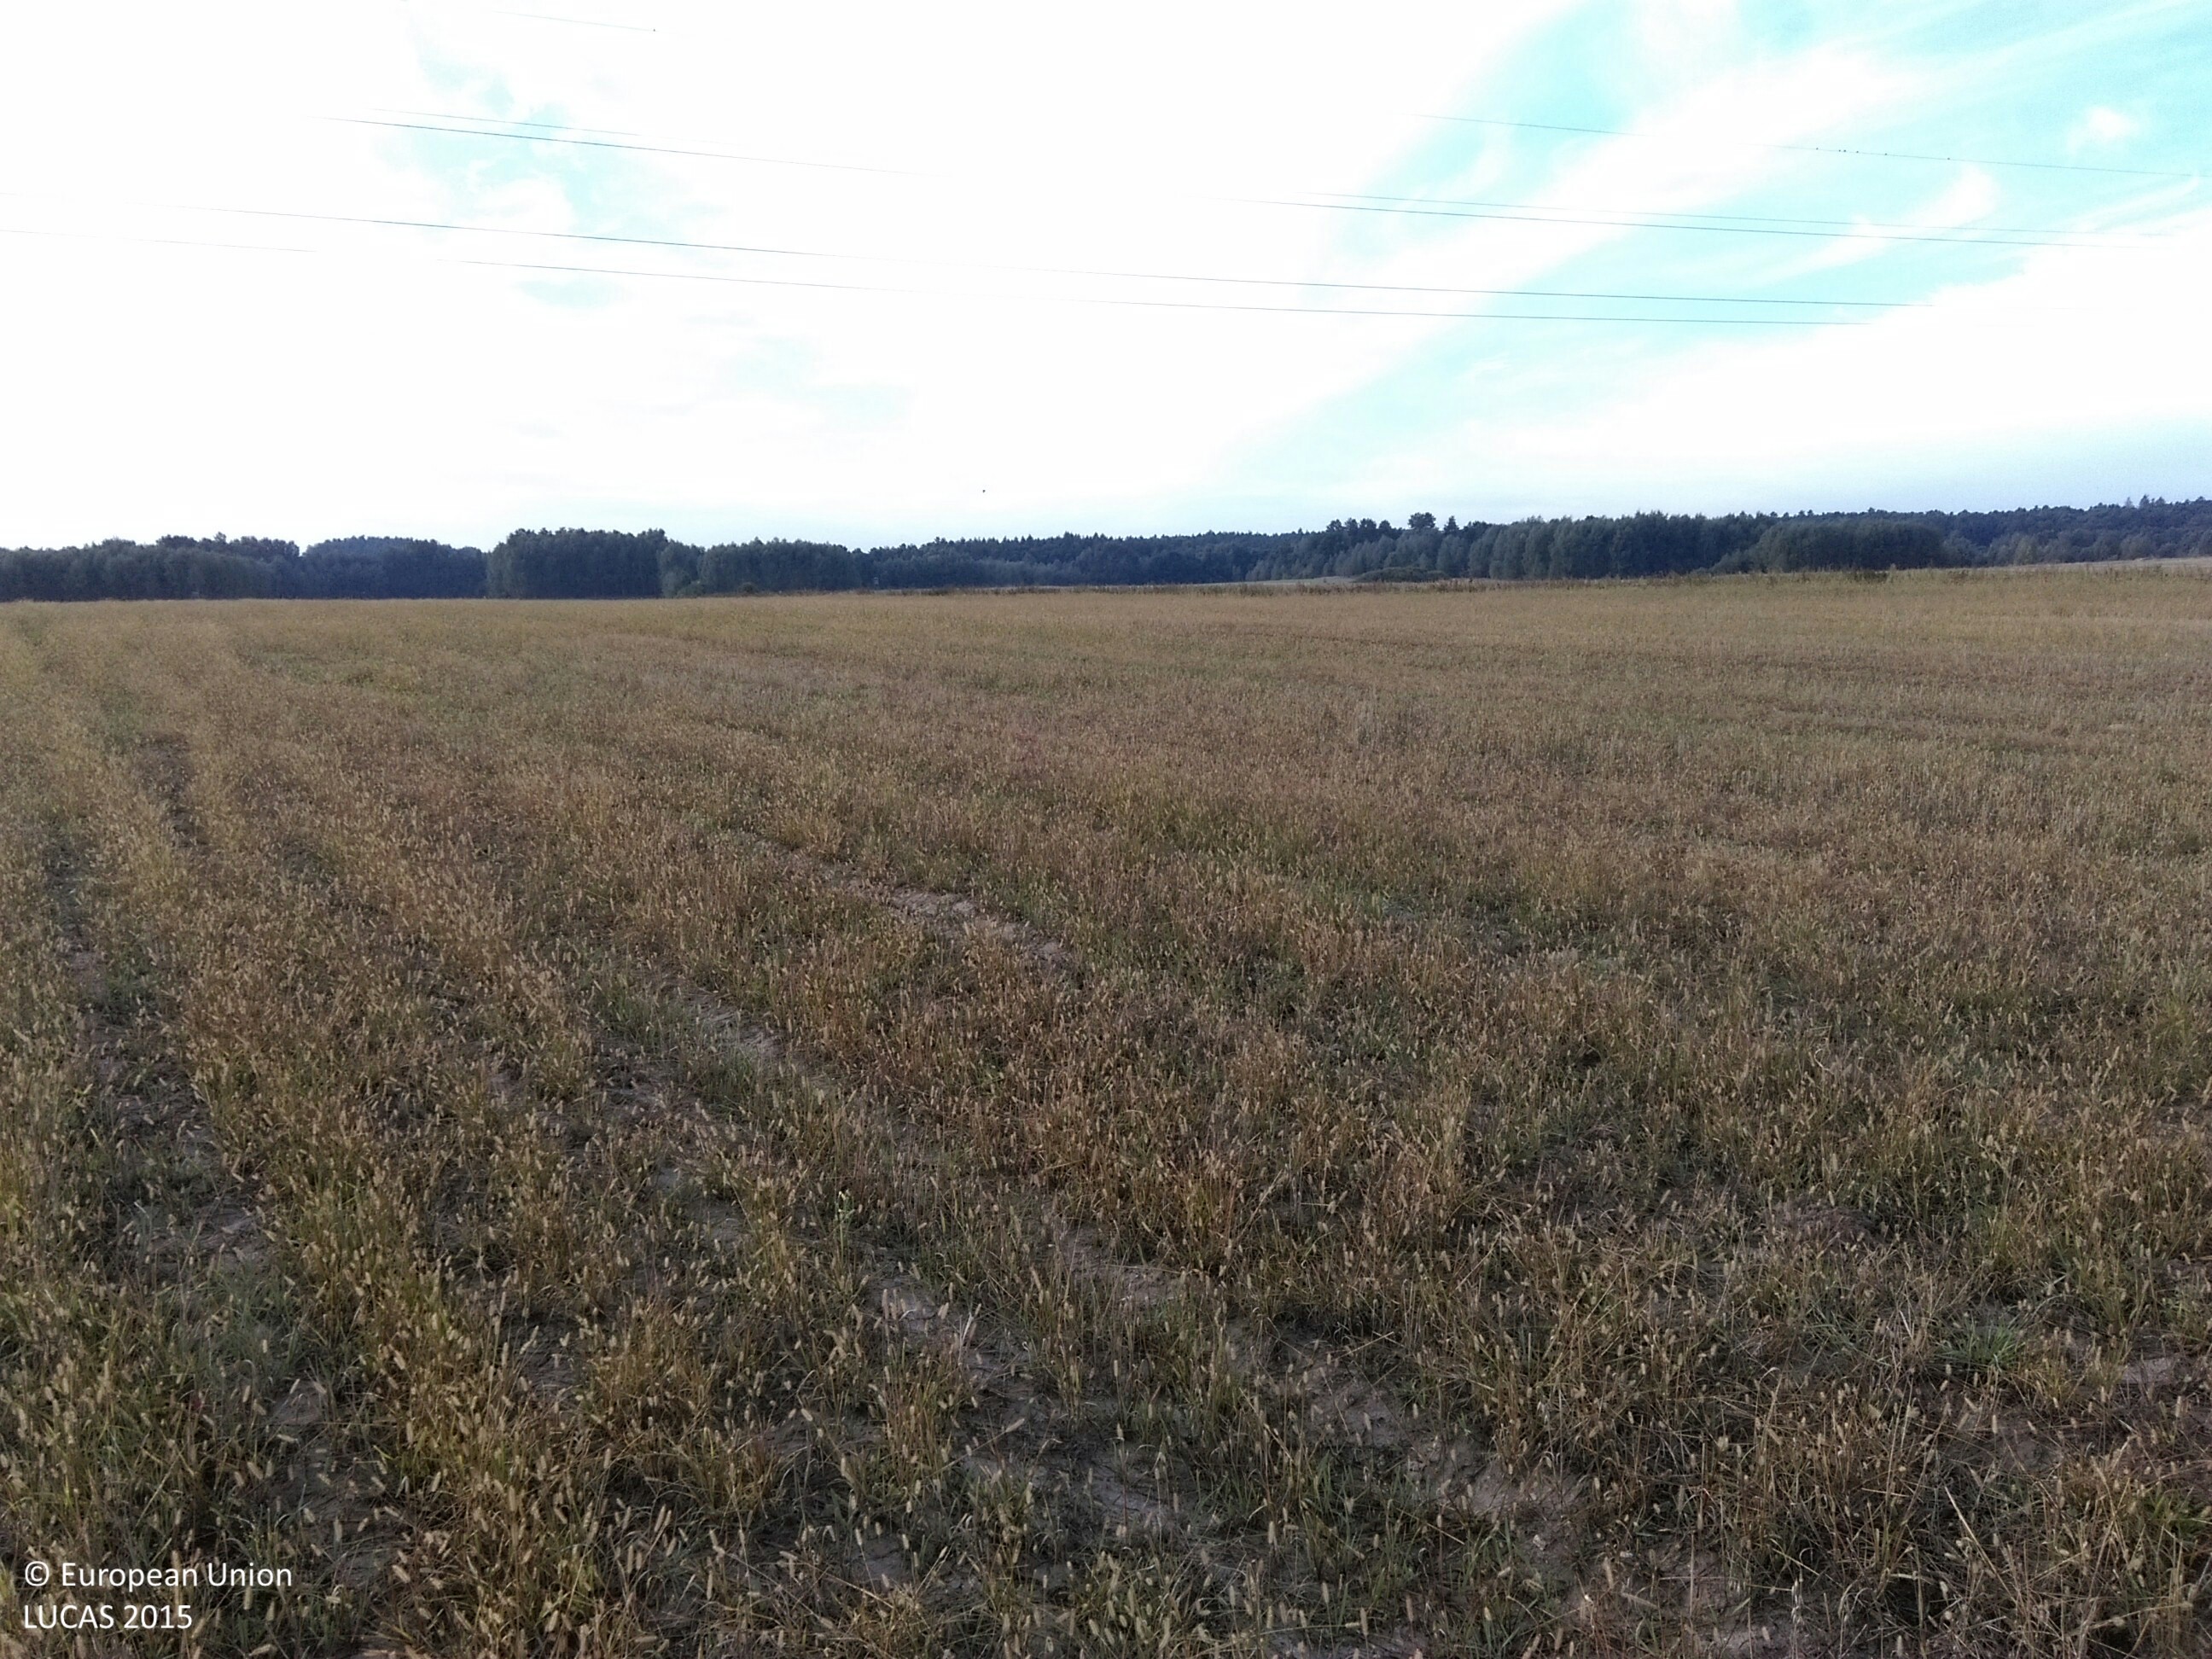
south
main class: Grassland
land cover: Grassland without tree/shrub cover
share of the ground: > 75 %
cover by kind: herbaceous plants 80 %, unconsolidated bare surface 20 %
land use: Agriculture (excluding fallow land and kitchen gardens)
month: September
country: PL
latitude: 51.7445
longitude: 15.5224
